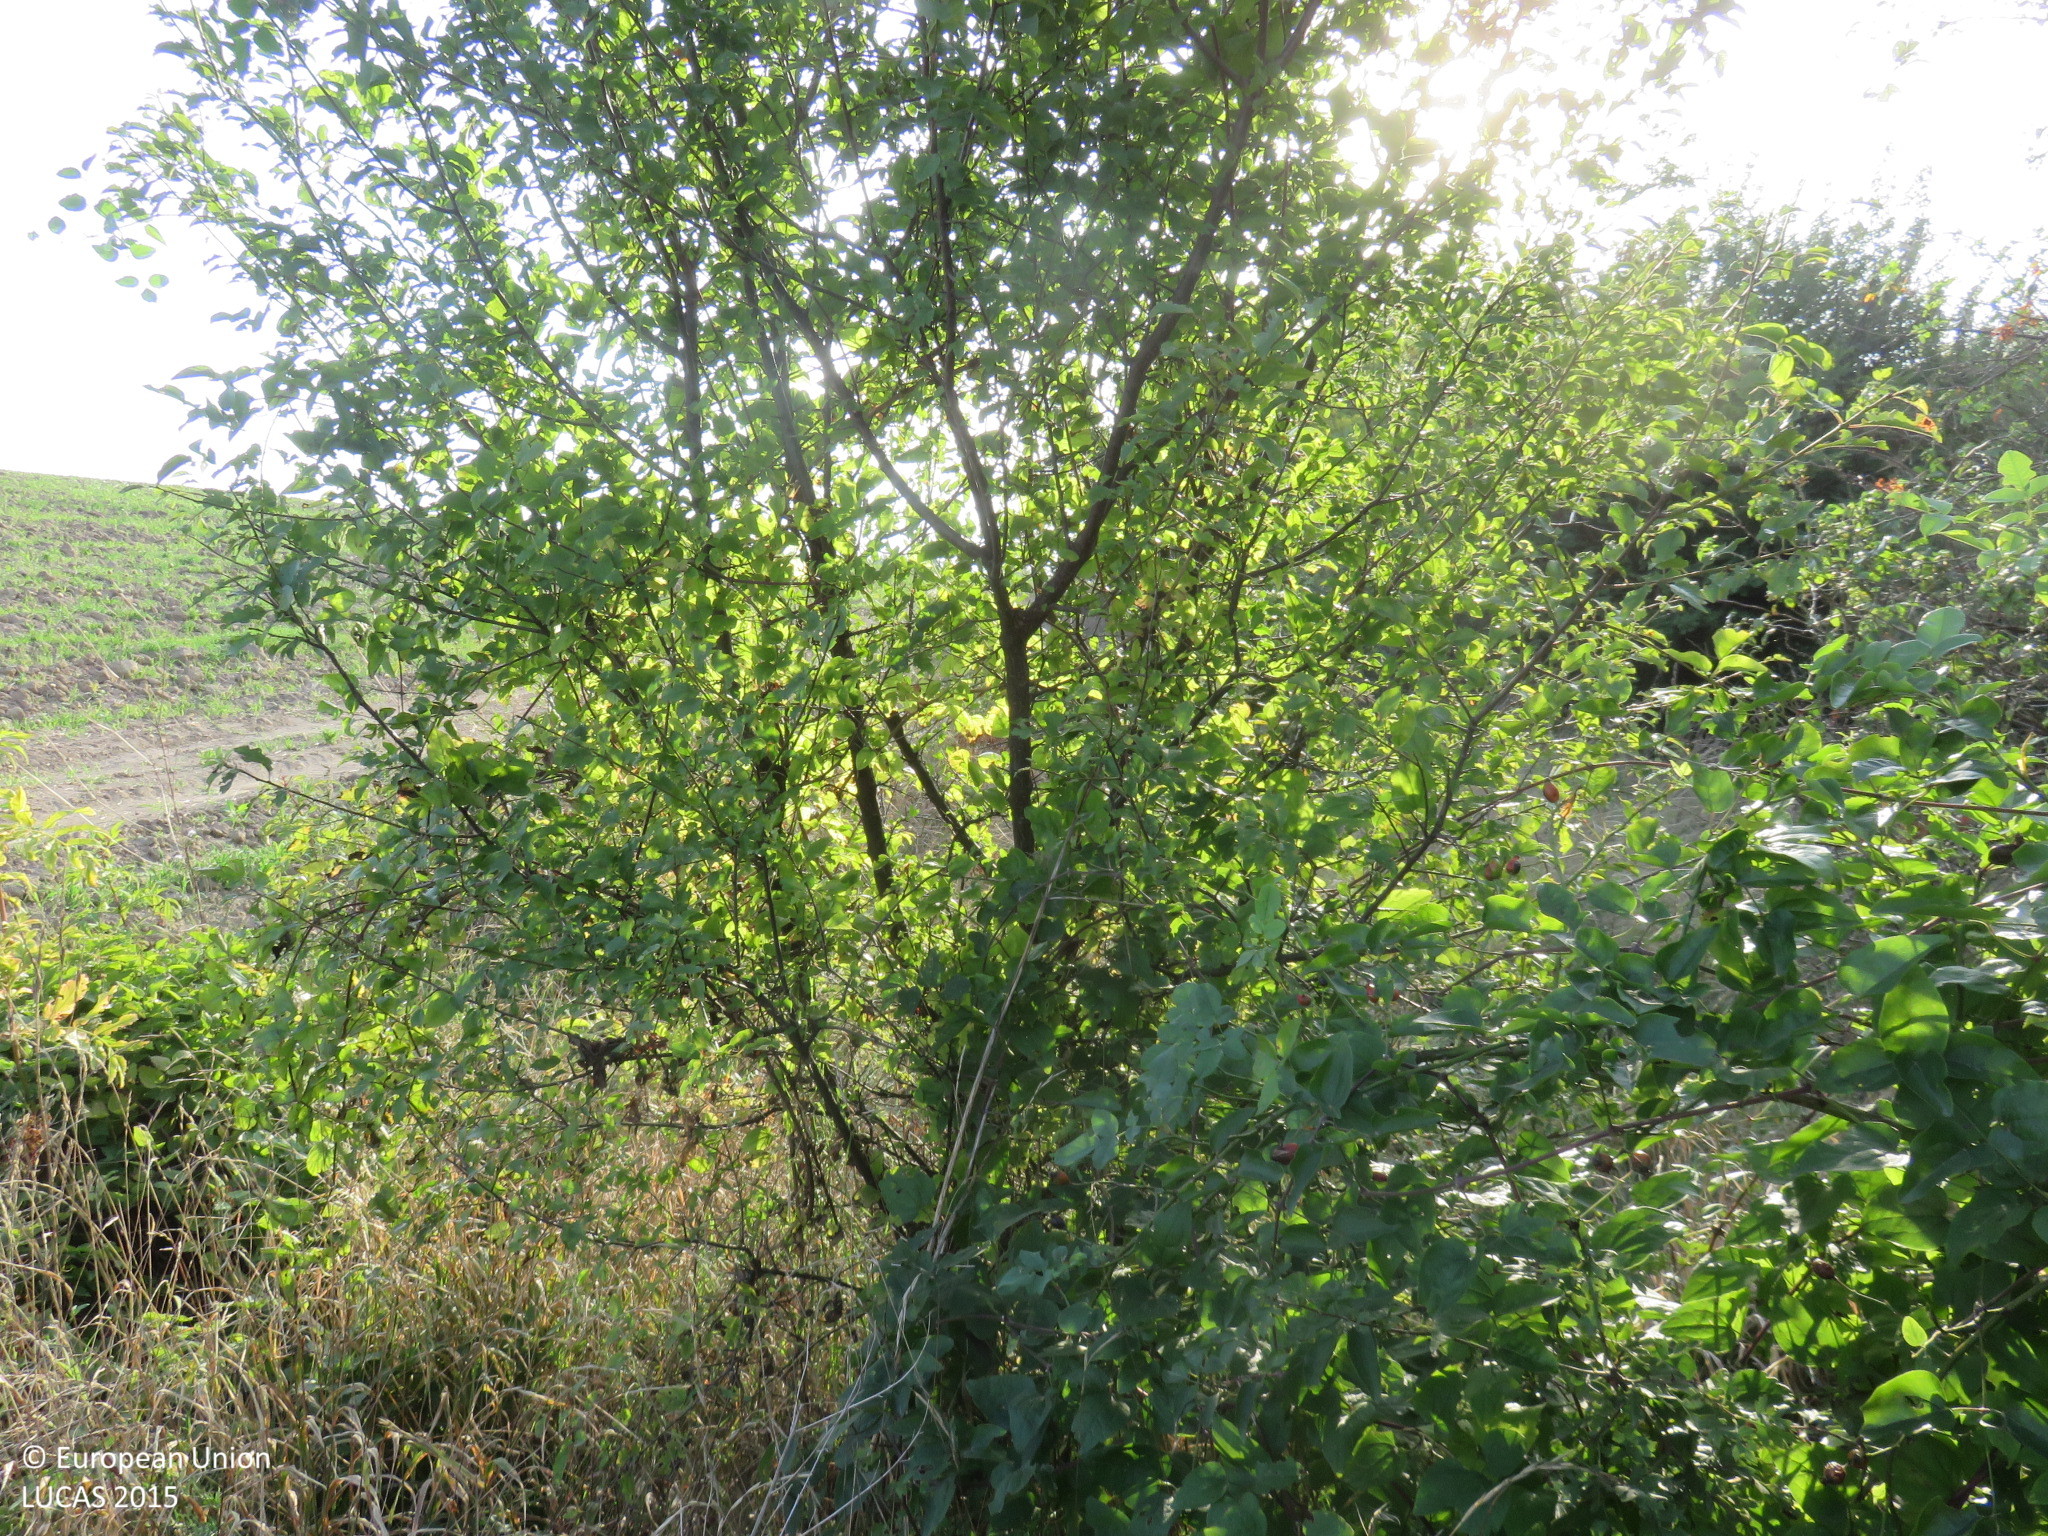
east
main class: Woodland
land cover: Broadleaved woodland
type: mesophytic deciduous forest
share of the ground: > 75 %
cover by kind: broadleaved forest trees 80 %, shrubs 15 %, herbaceous plants 5 %
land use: Forestry
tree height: < 5 m
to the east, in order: Broadleaved woodland; Grassland with sparse tree/shrub cover; Other bare soil; Tracks; Other bare soil
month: September
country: BG
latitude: 43.5621
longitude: 25.0150
